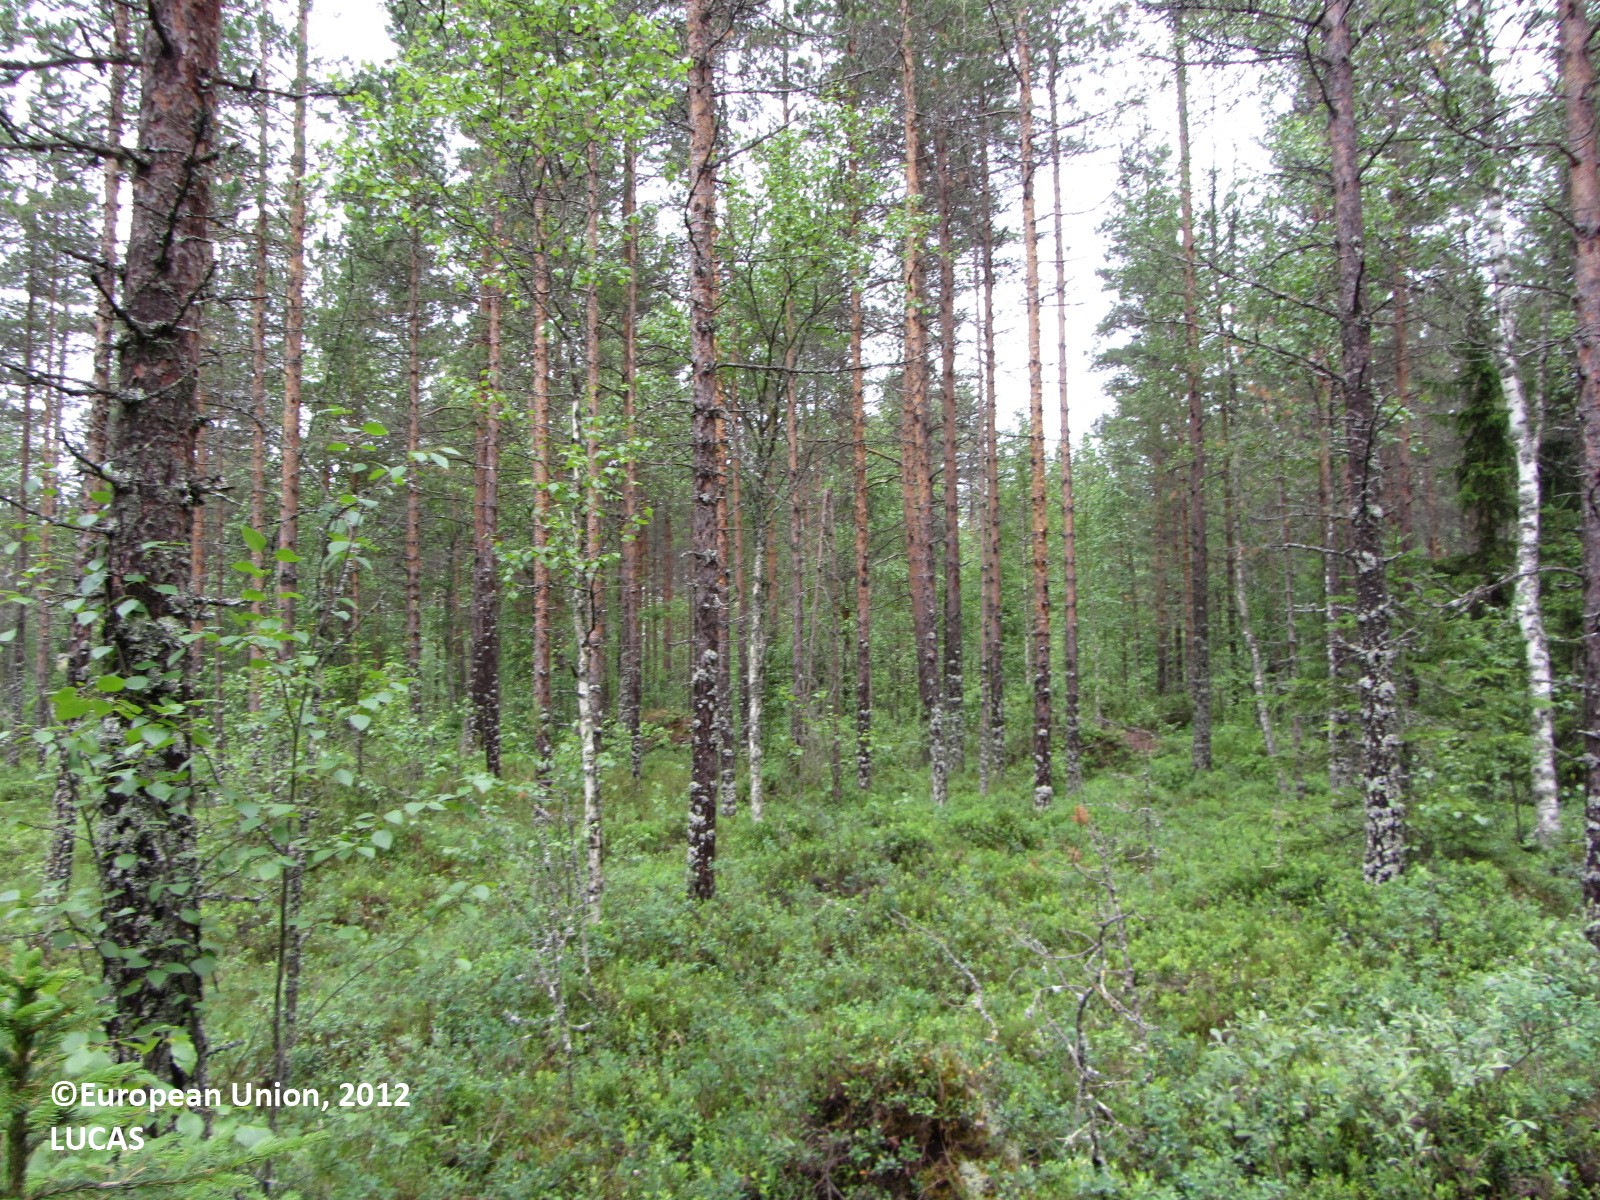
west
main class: Woodland
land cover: Pine dominated coniferous woodland
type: boreal forest
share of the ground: 50 - 75 %
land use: Forestry
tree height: > 5 m
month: July
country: FI
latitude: 63.8577
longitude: 25.6216
